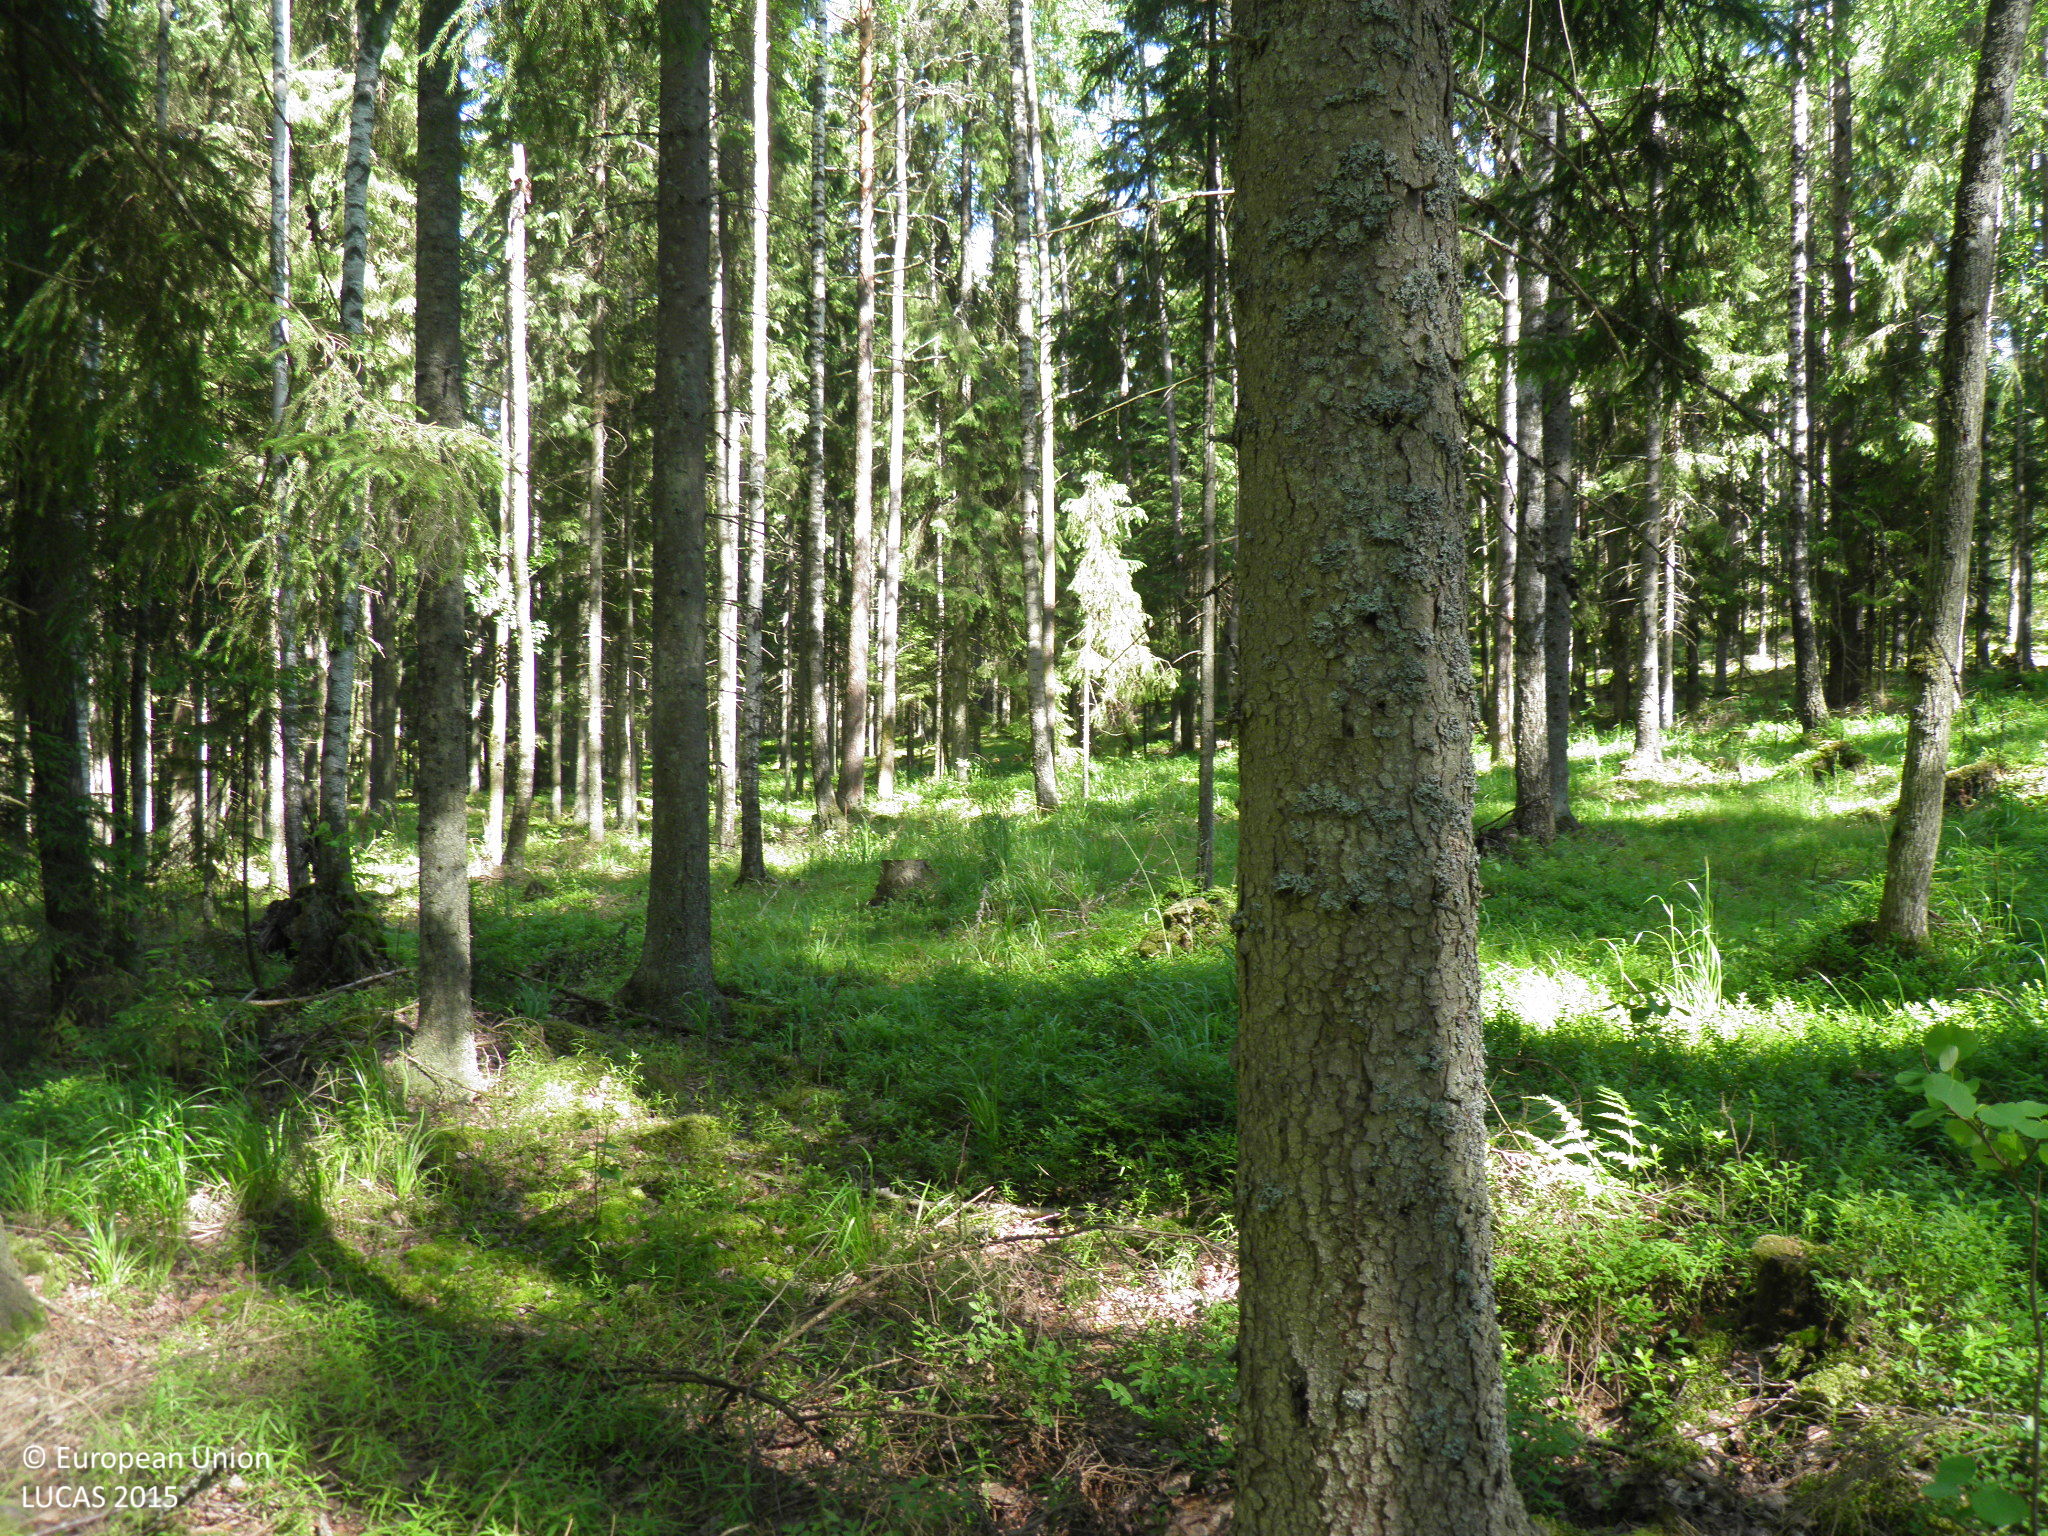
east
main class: Woodland
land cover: Spruce dominated mixed woodland
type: hemiboreal forest and nemoral coniferous forest and mixed broadleaved-coniferous forest
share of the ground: 50 - 75 %
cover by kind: coniferous forest trees 35 %, broadleaved forest trees 35 %, shrubs 10 %, herbaceous plants 10 %, unconsolidated bare surface 10 %
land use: Forestry
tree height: > 5 m
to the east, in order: Spruce dominated mixed woodland; Spruce dominated coniferous woodland
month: June
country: FI
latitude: 60.4661
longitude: 22.8612
